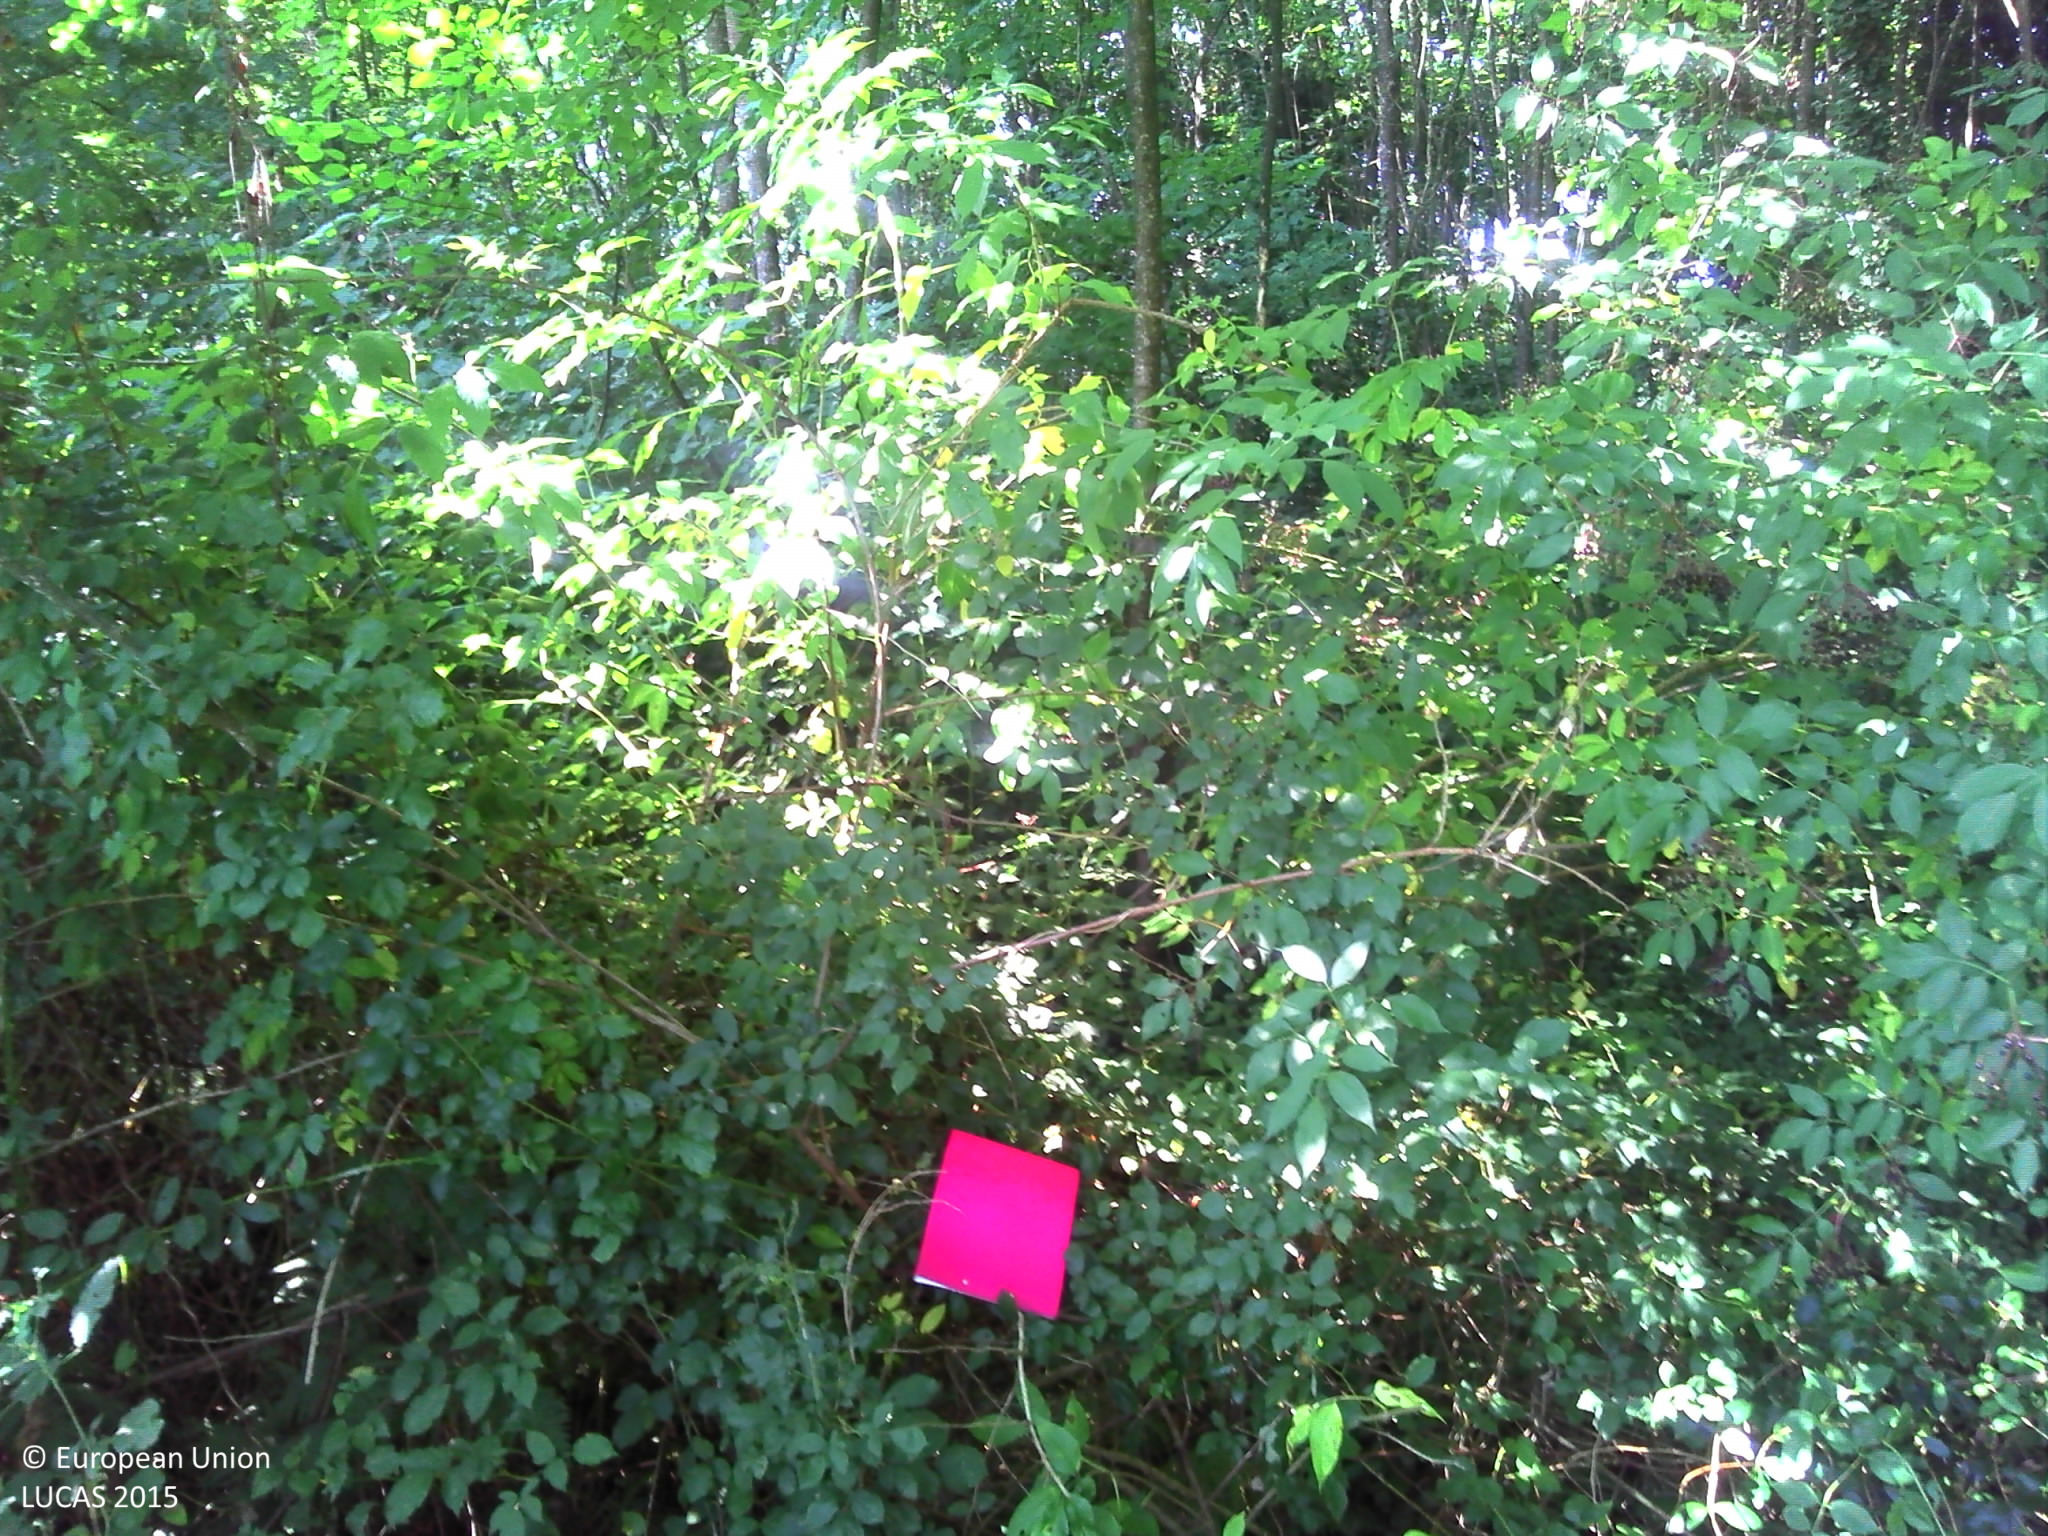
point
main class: Woodland
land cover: Broadleaved woodland
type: thermophilous deciduous forest
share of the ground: > 75 %
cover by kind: broadleaved forest trees 65 %, shrubs 20 %, herbaceous plants 10 %, lichens and mosses 5 %
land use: Forestry
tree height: > 5 m
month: August
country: FR
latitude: 43.4771
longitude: -1.1289
